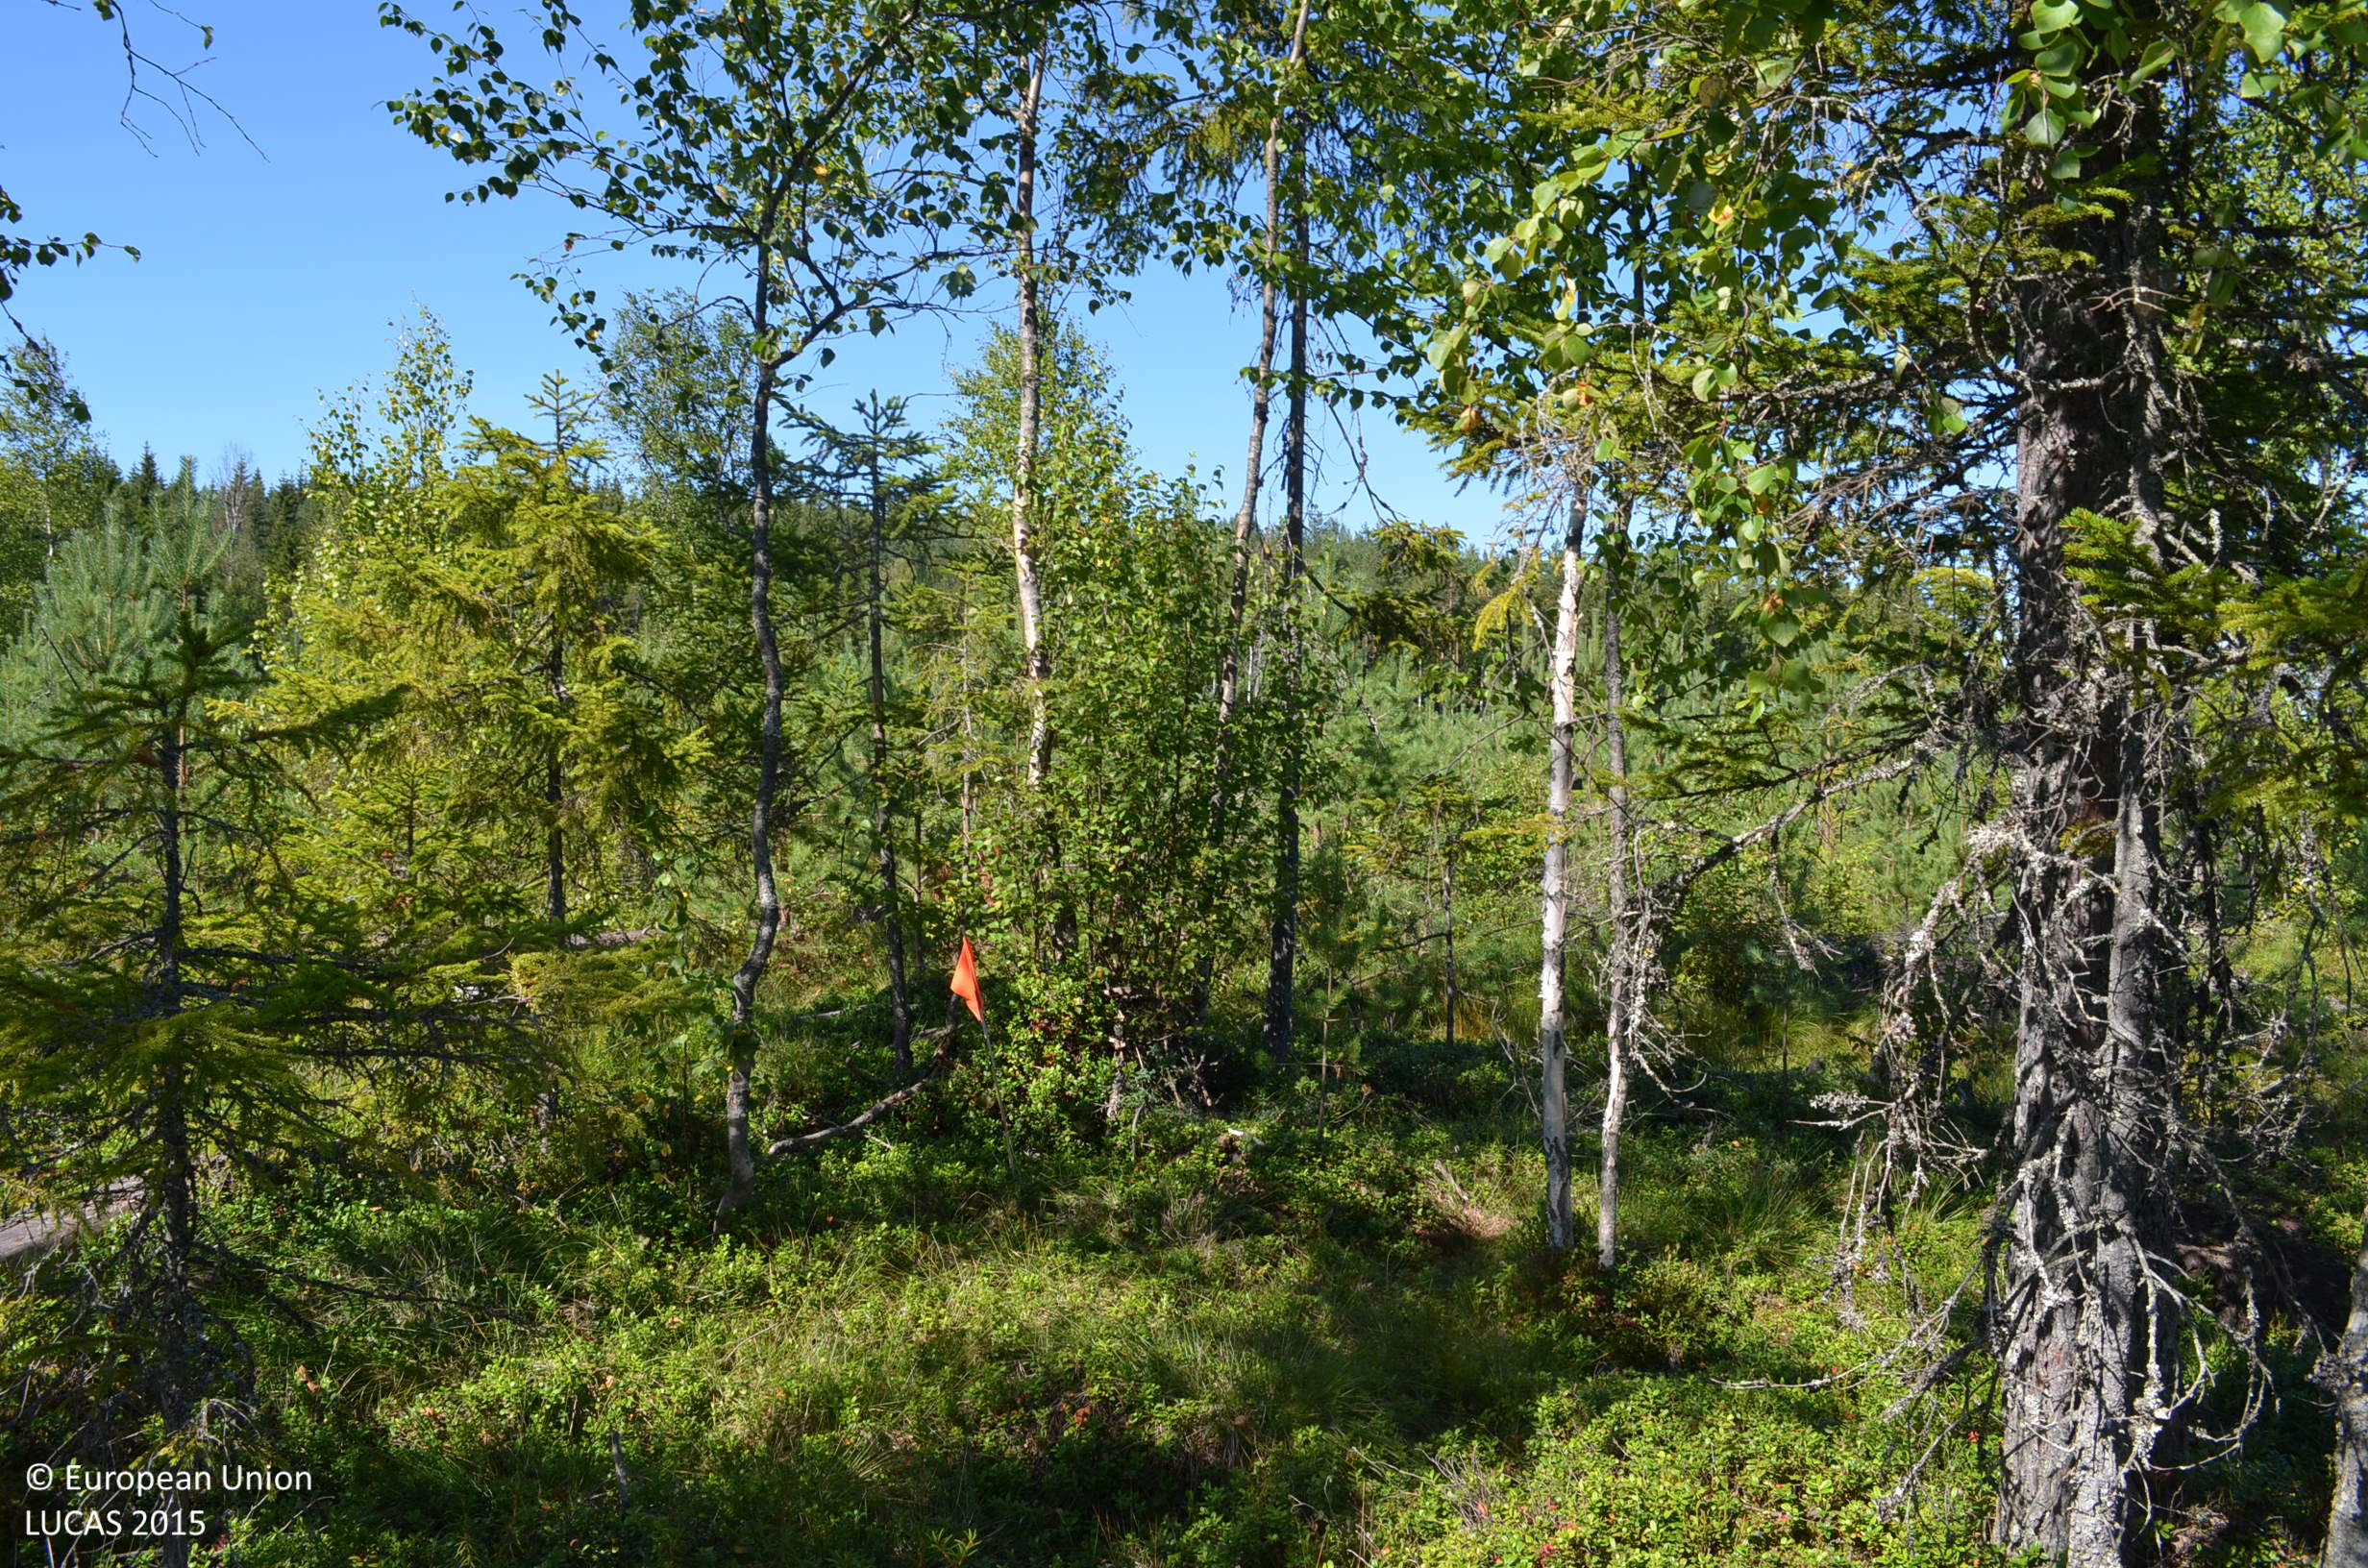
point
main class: Woodland
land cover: Other mixed woodland
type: boreal forest
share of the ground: 50 - 75 %
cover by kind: coniferous forest trees 50 %, shrubs 25 %, broadleaved forest trees 20 %, herbaceous plants 5 %
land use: Forestry
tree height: < 5 m
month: August
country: FI
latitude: 62.1486
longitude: 24.2676
